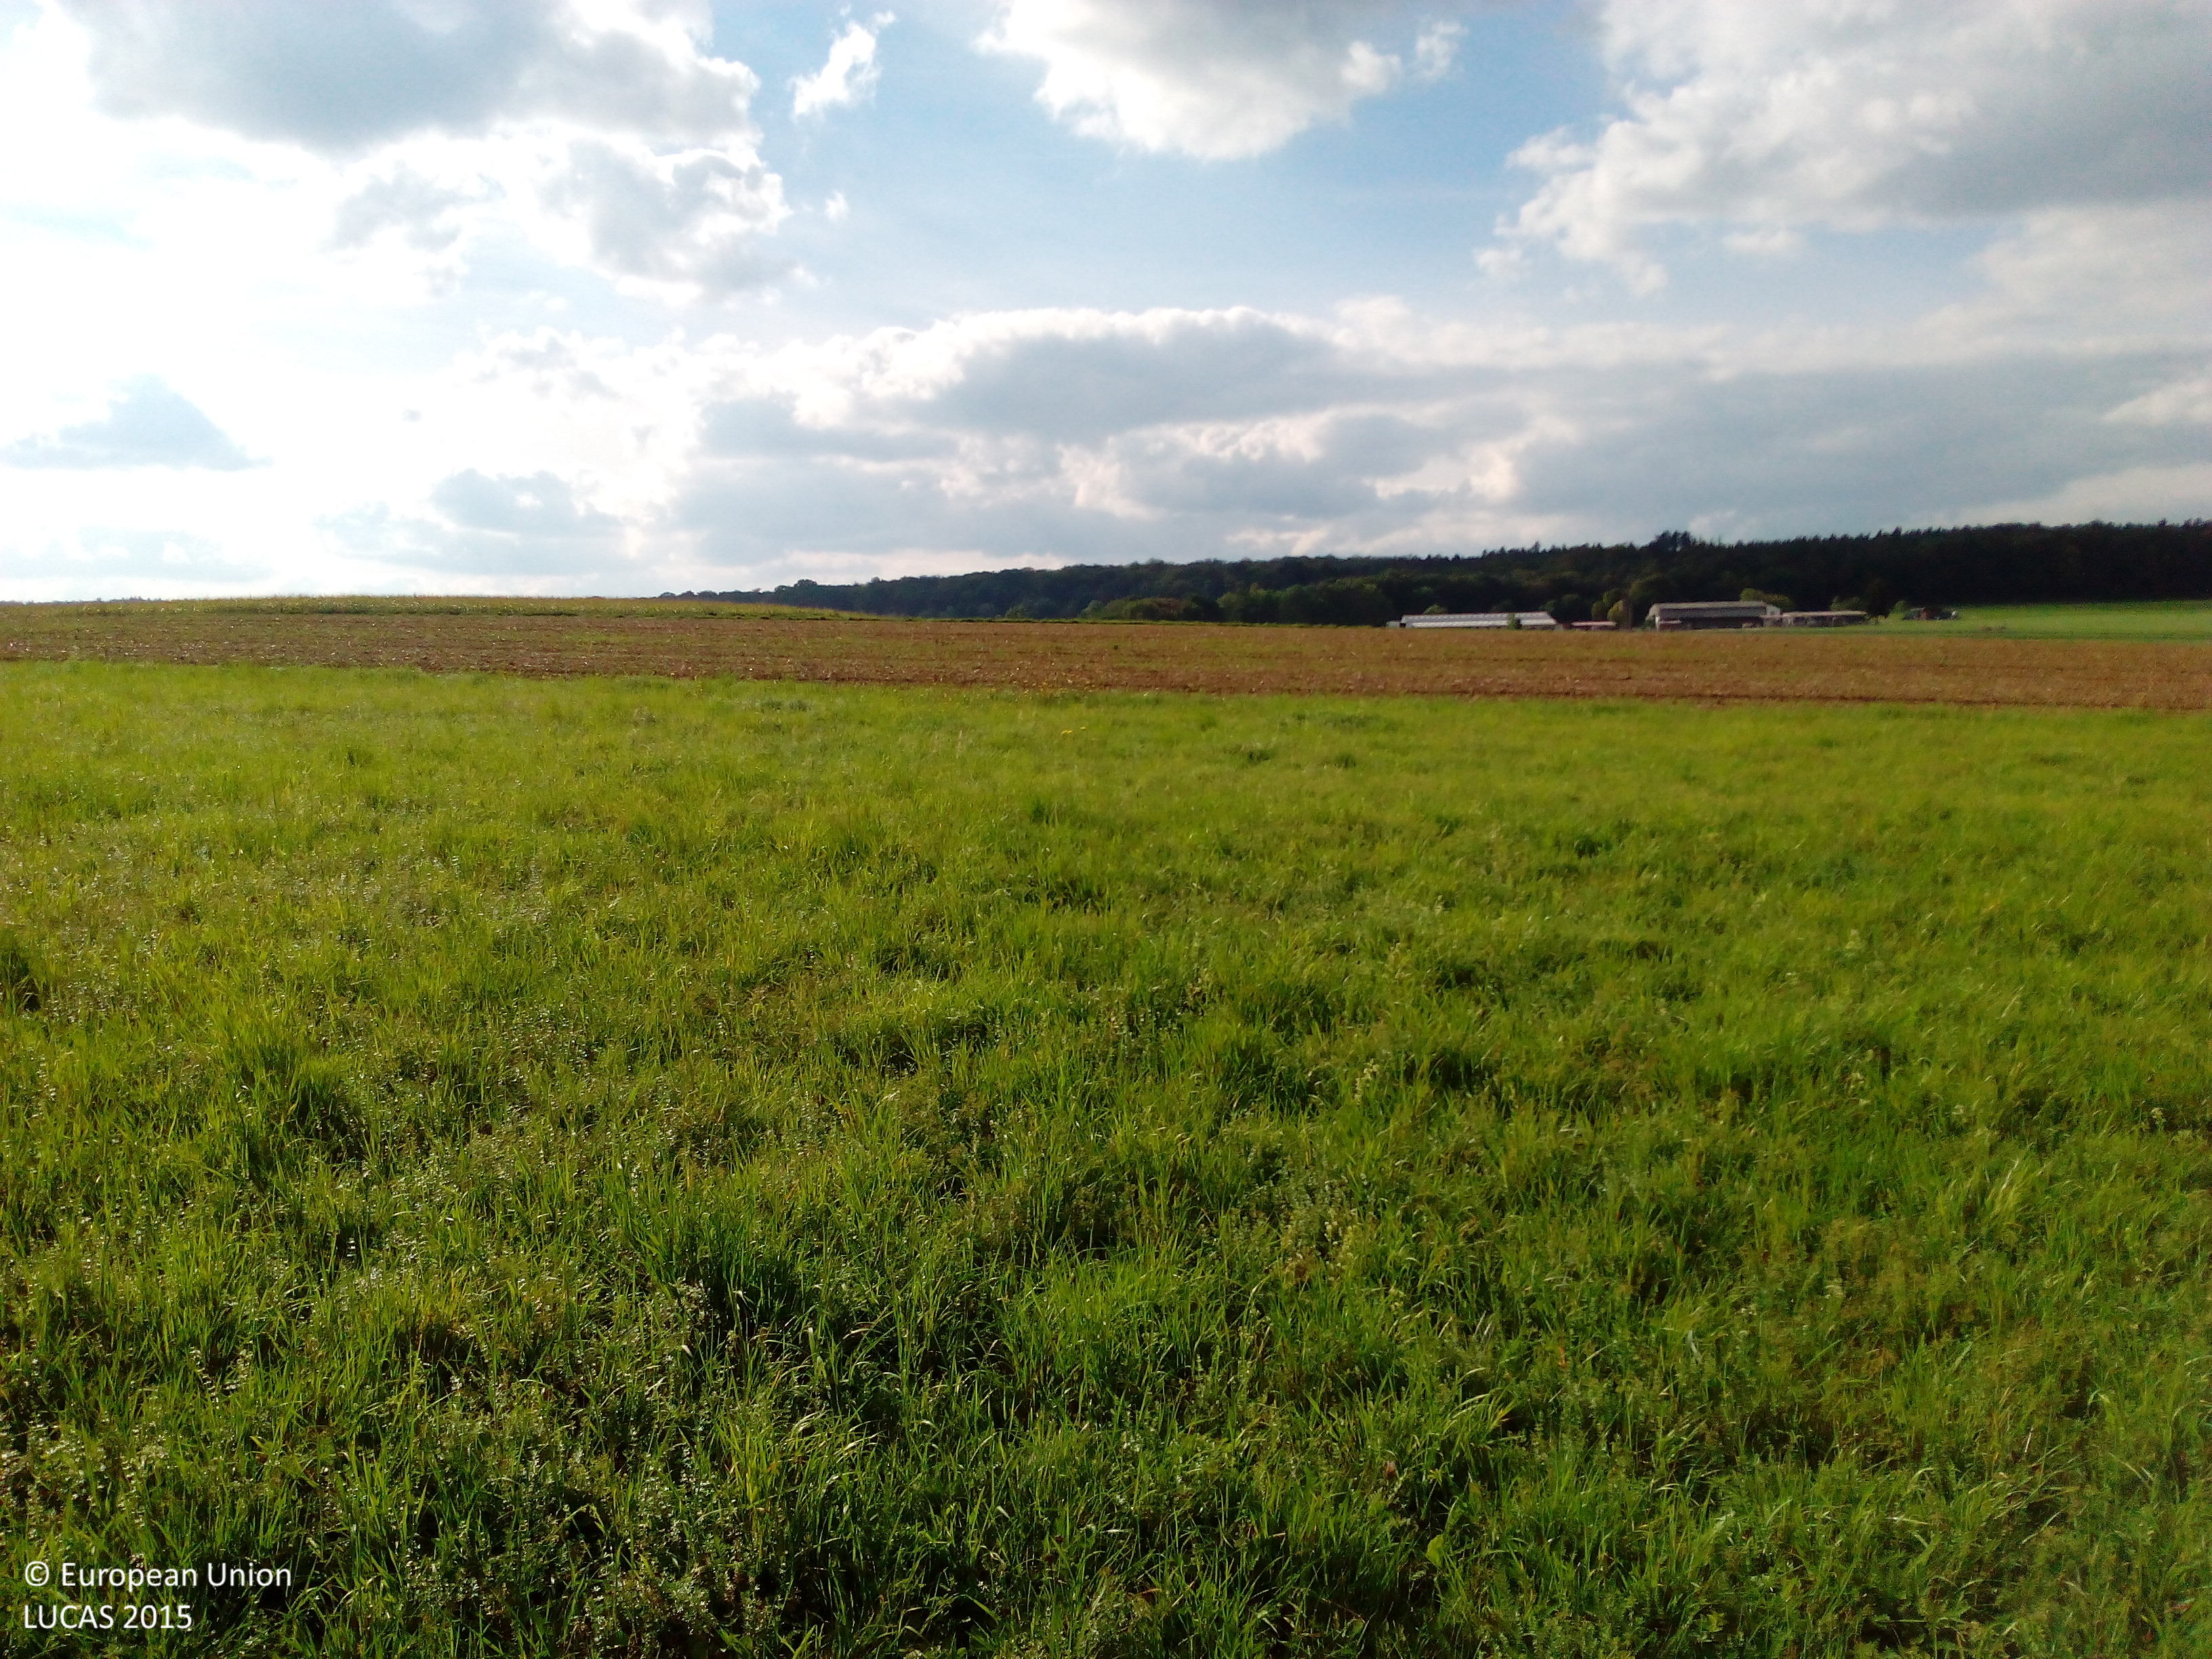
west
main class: Cropland
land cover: Rape and turnip rape
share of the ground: < 10 %
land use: Agriculture (excluding fallow land and kitchen gardens)
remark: Harvested field
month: September
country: DE
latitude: 50.4994
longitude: 8.6046
